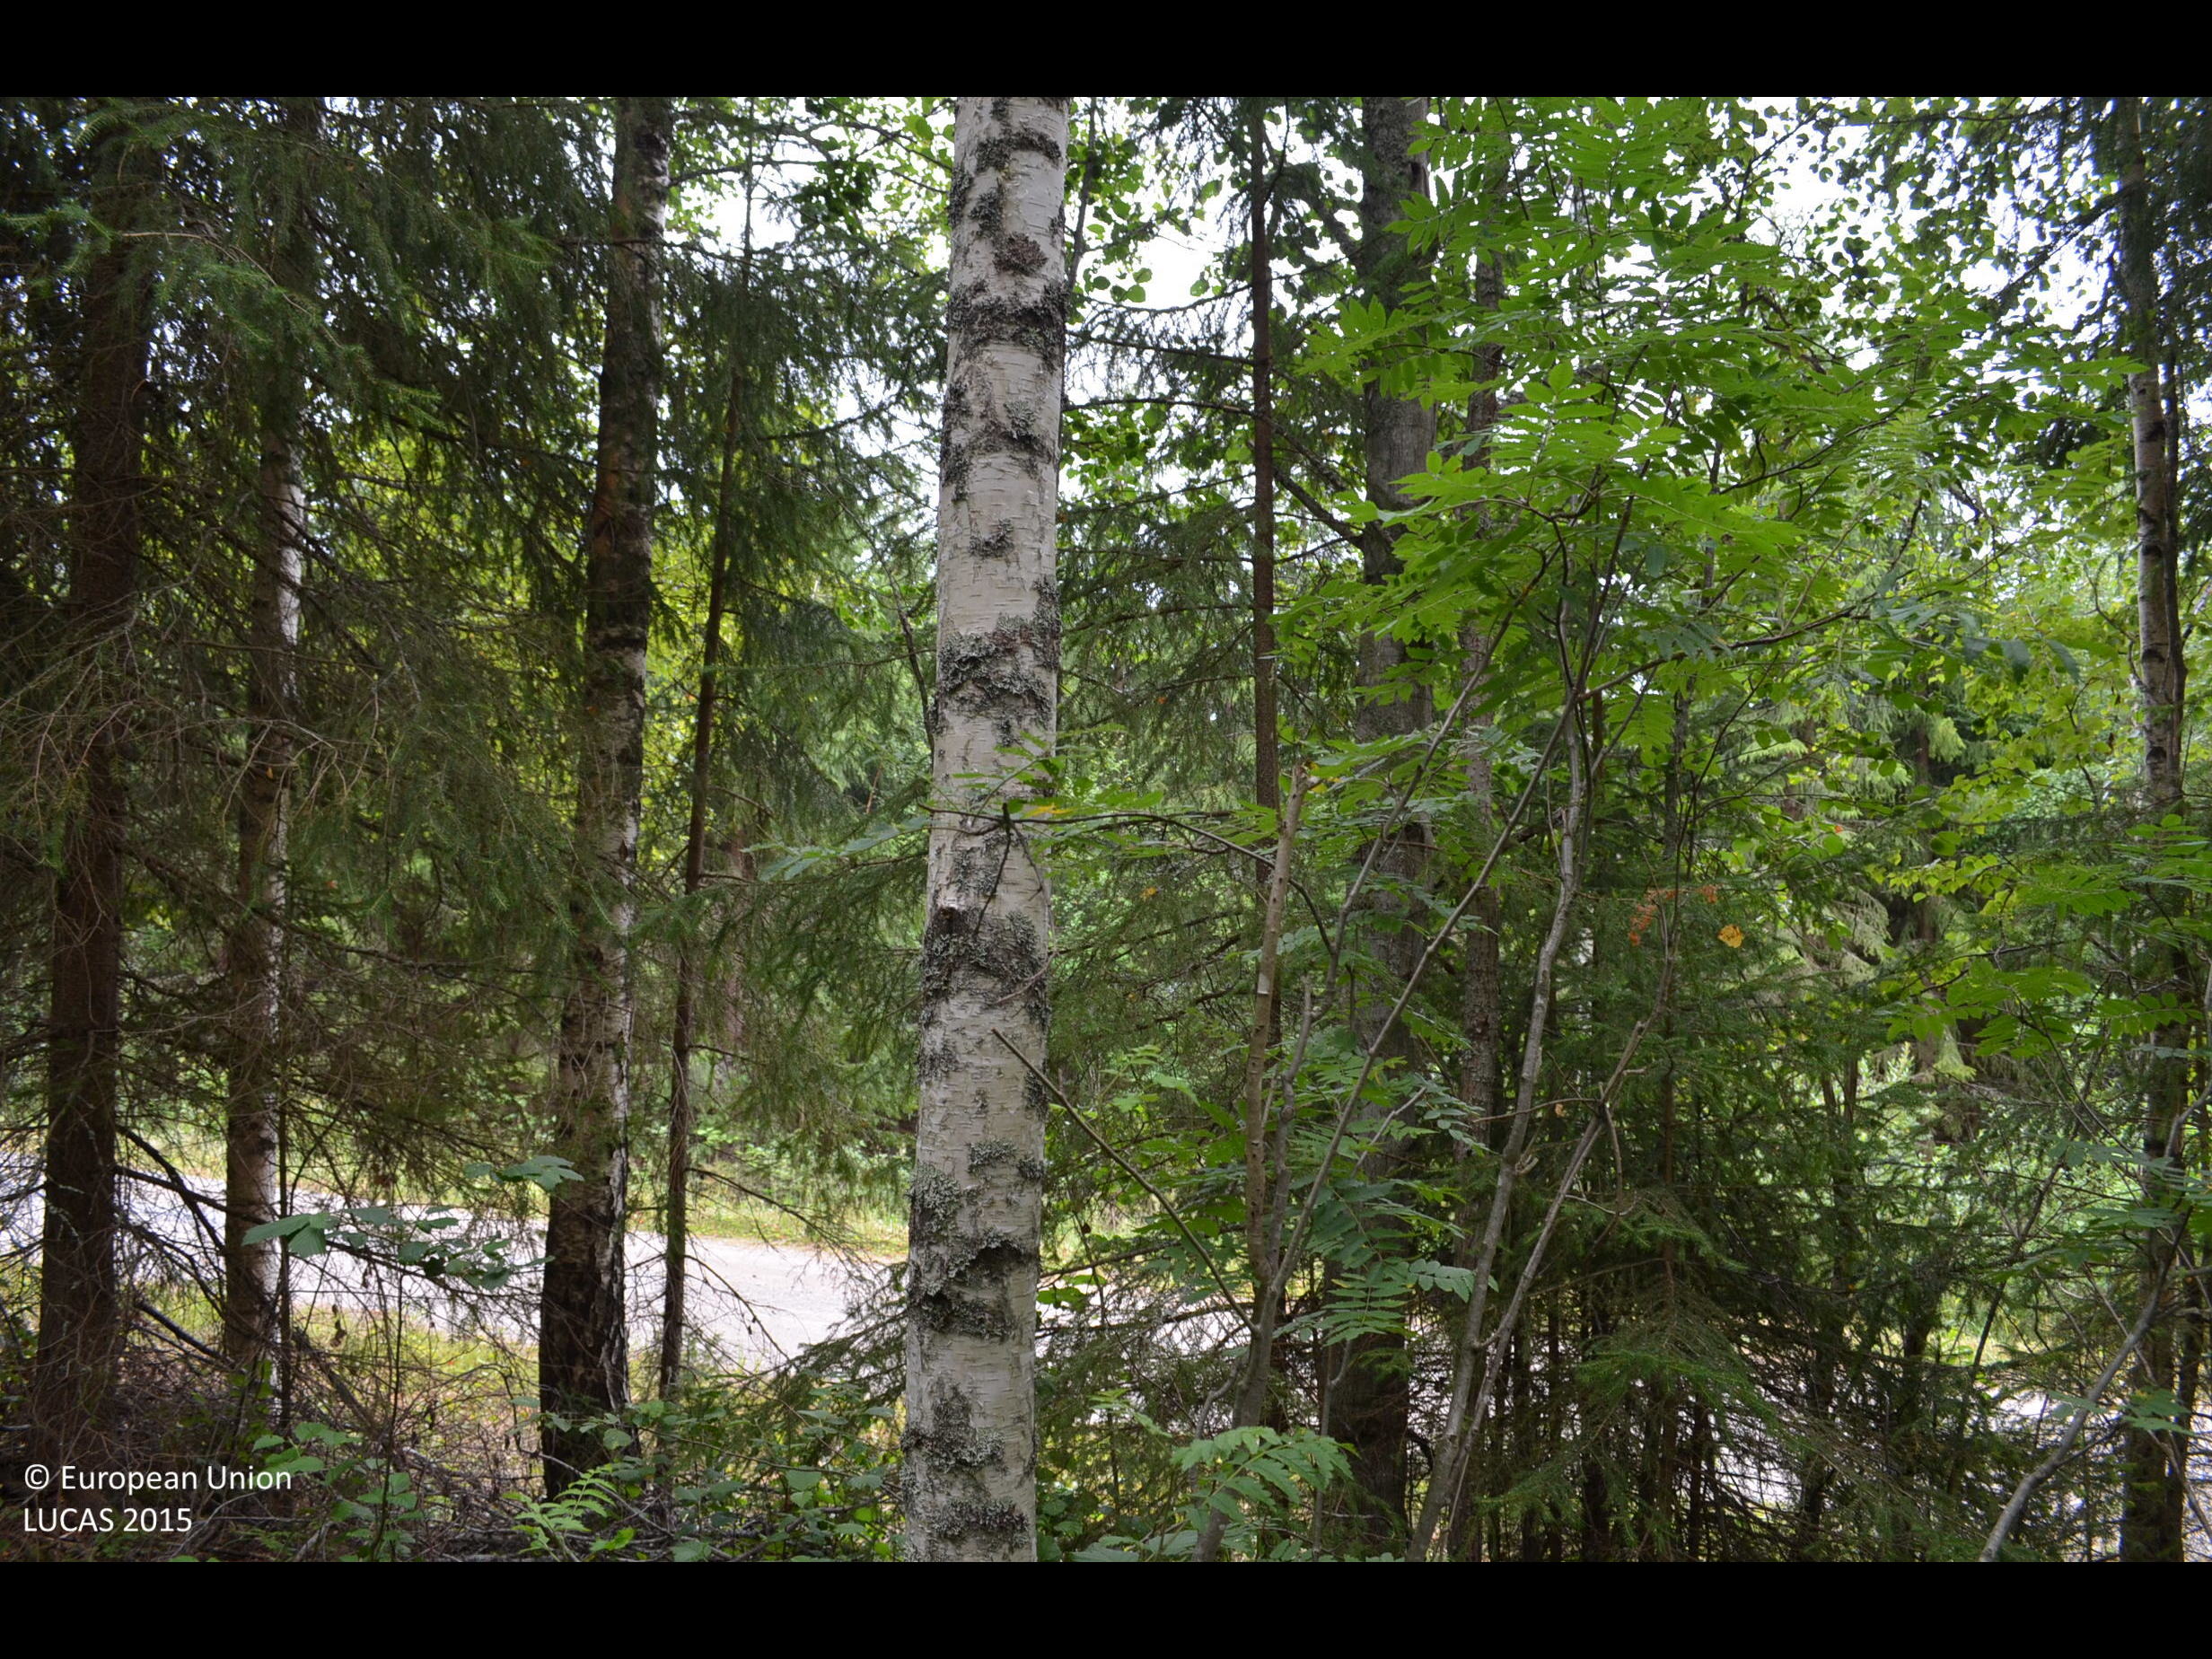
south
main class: Woodland
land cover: Other mixed woodland
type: boreal forest
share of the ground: > 75 %
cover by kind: broadleaved forest trees 45 %, coniferous forest trees 35 %, shrubs 20 %
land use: Forestry
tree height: > 5 m
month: August
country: FI
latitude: 62.1801
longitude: 24.3216
